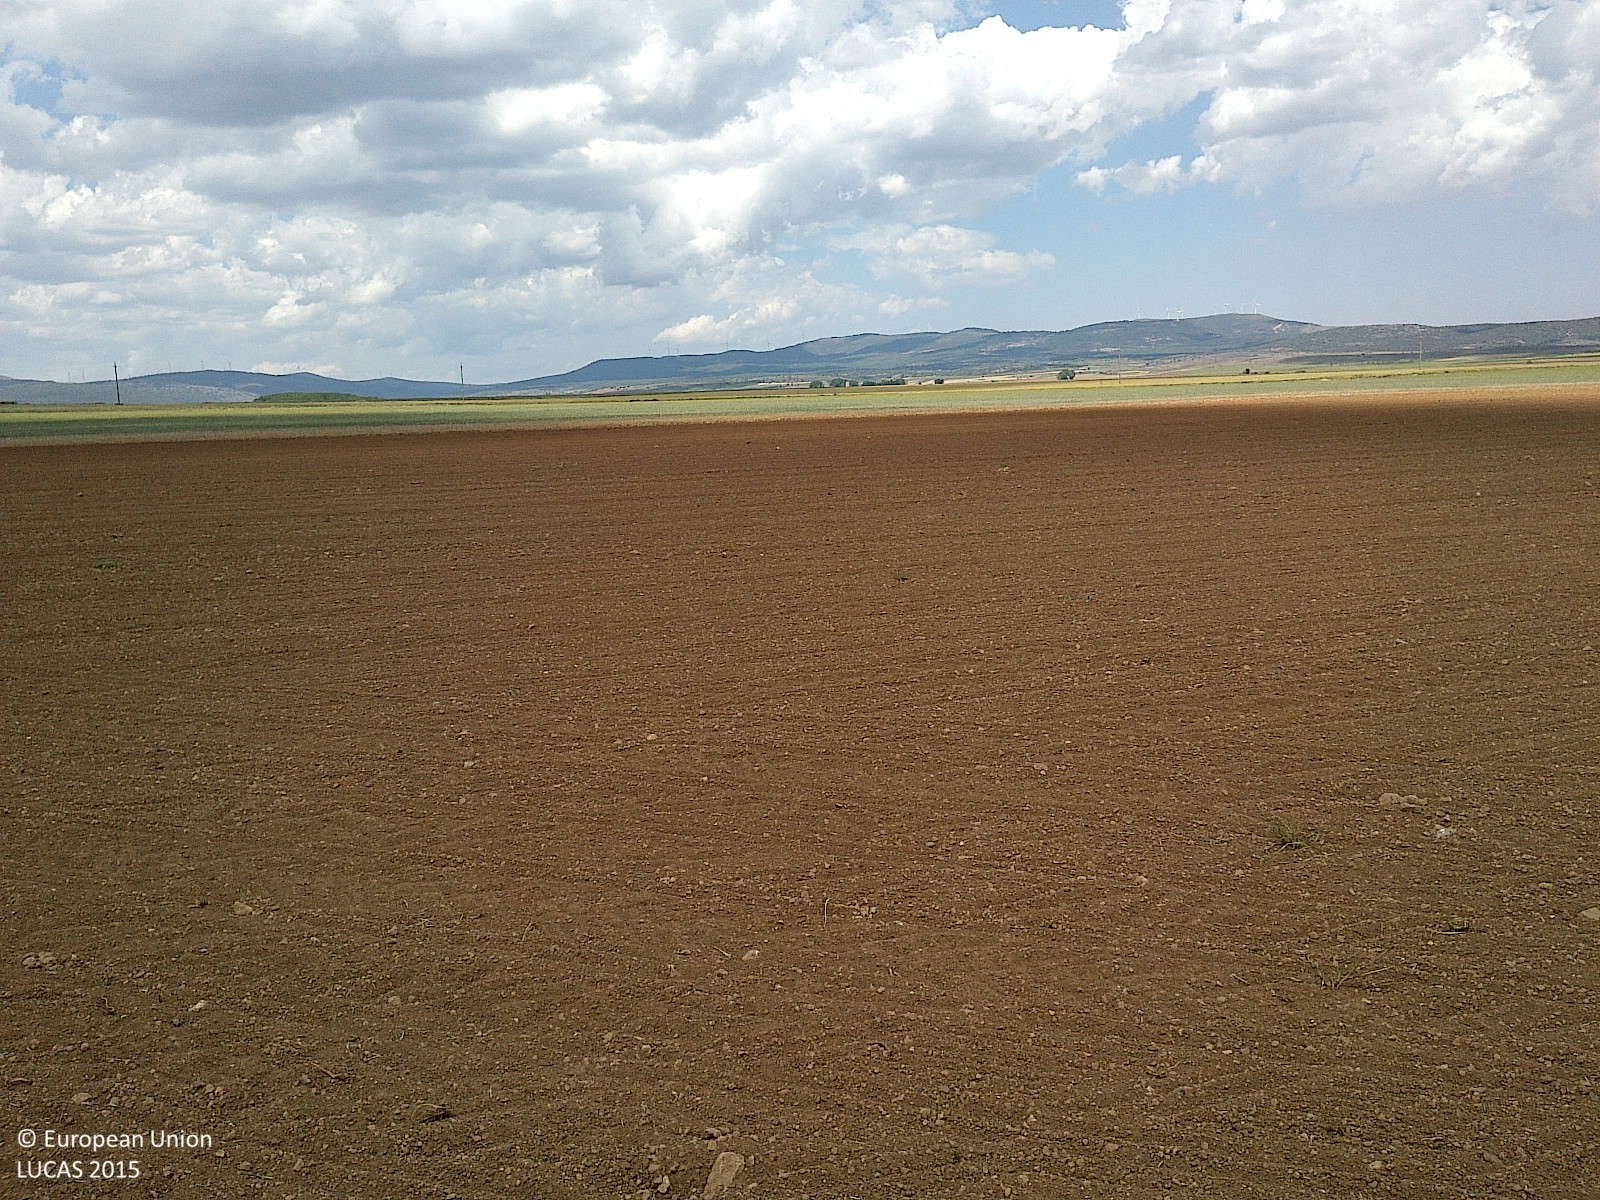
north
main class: Cropland
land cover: Sunflower
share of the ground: < 10 %
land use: Agriculture (excluding fallow land and kitchen gardens)
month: June
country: ES
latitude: 41.7382
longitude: -2.1419
